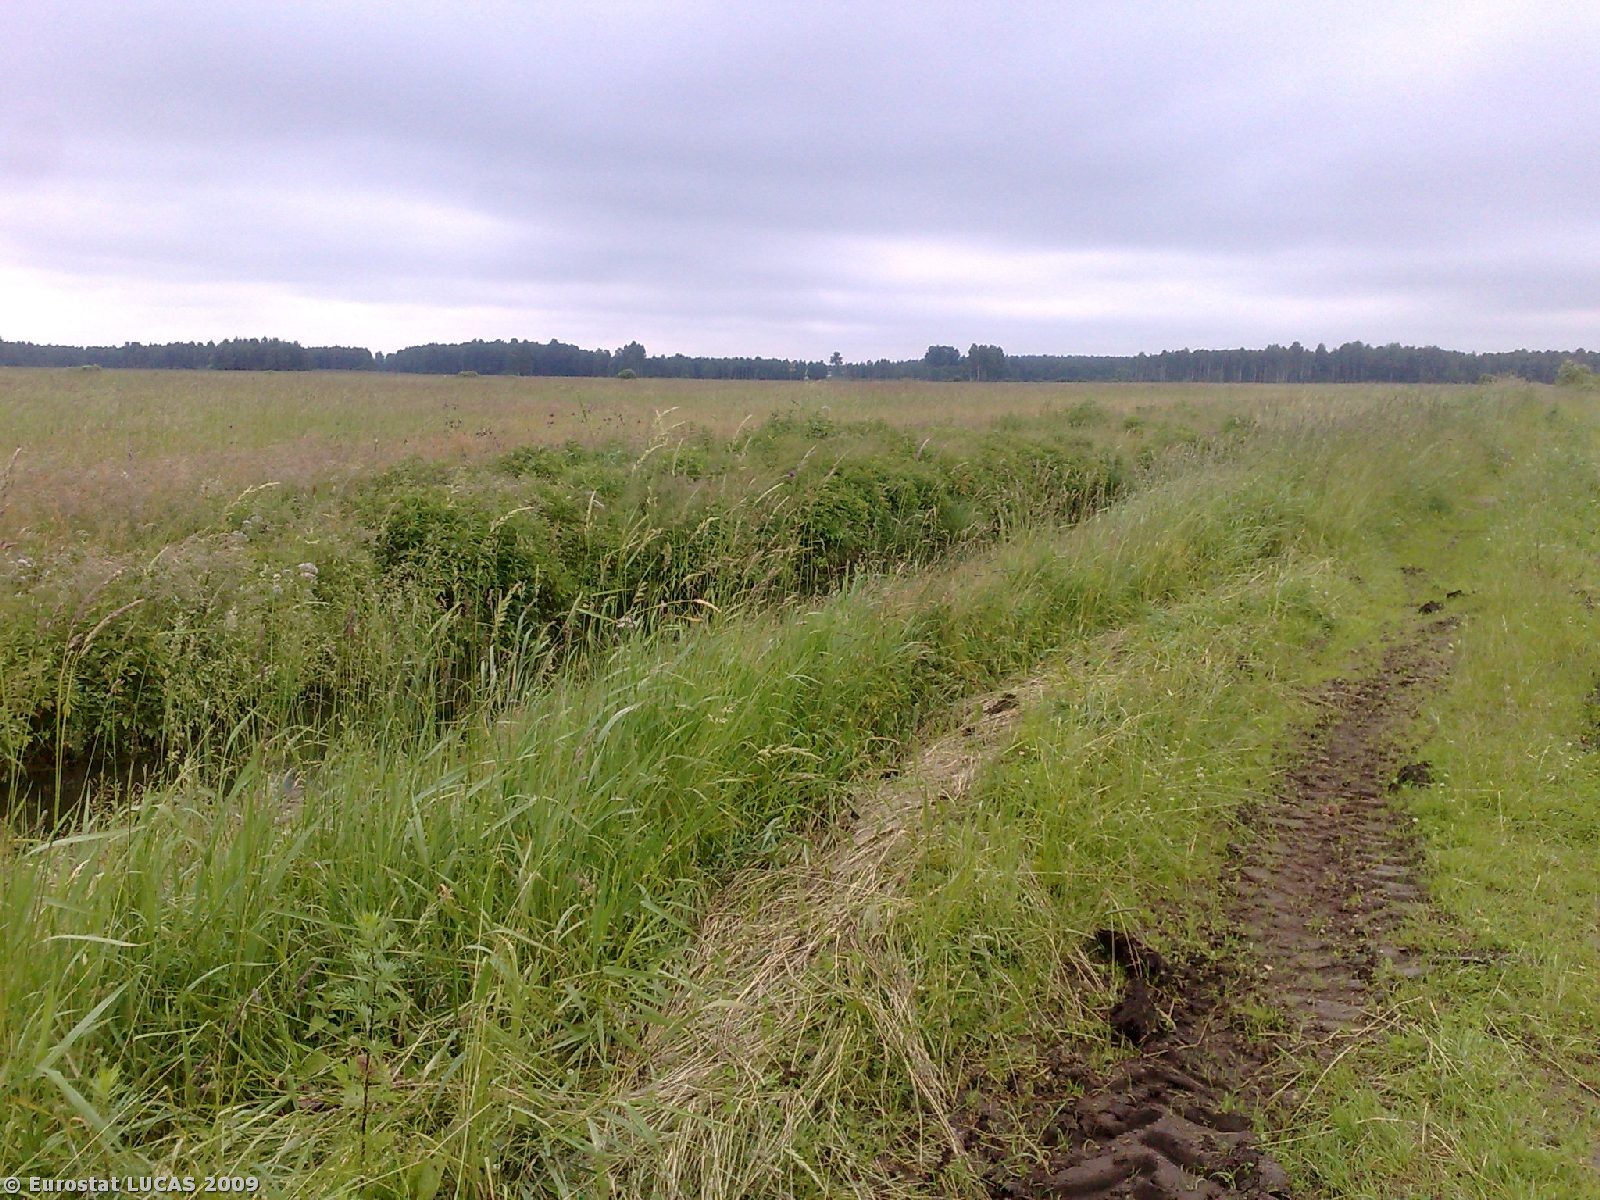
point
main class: Grassland
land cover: Grassland without tree/shrub cover
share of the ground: > 75 %
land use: Agriculture (excluding fallow land and kitchen gardens)
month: June
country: PL
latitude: 53.7251
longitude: 23.4344
